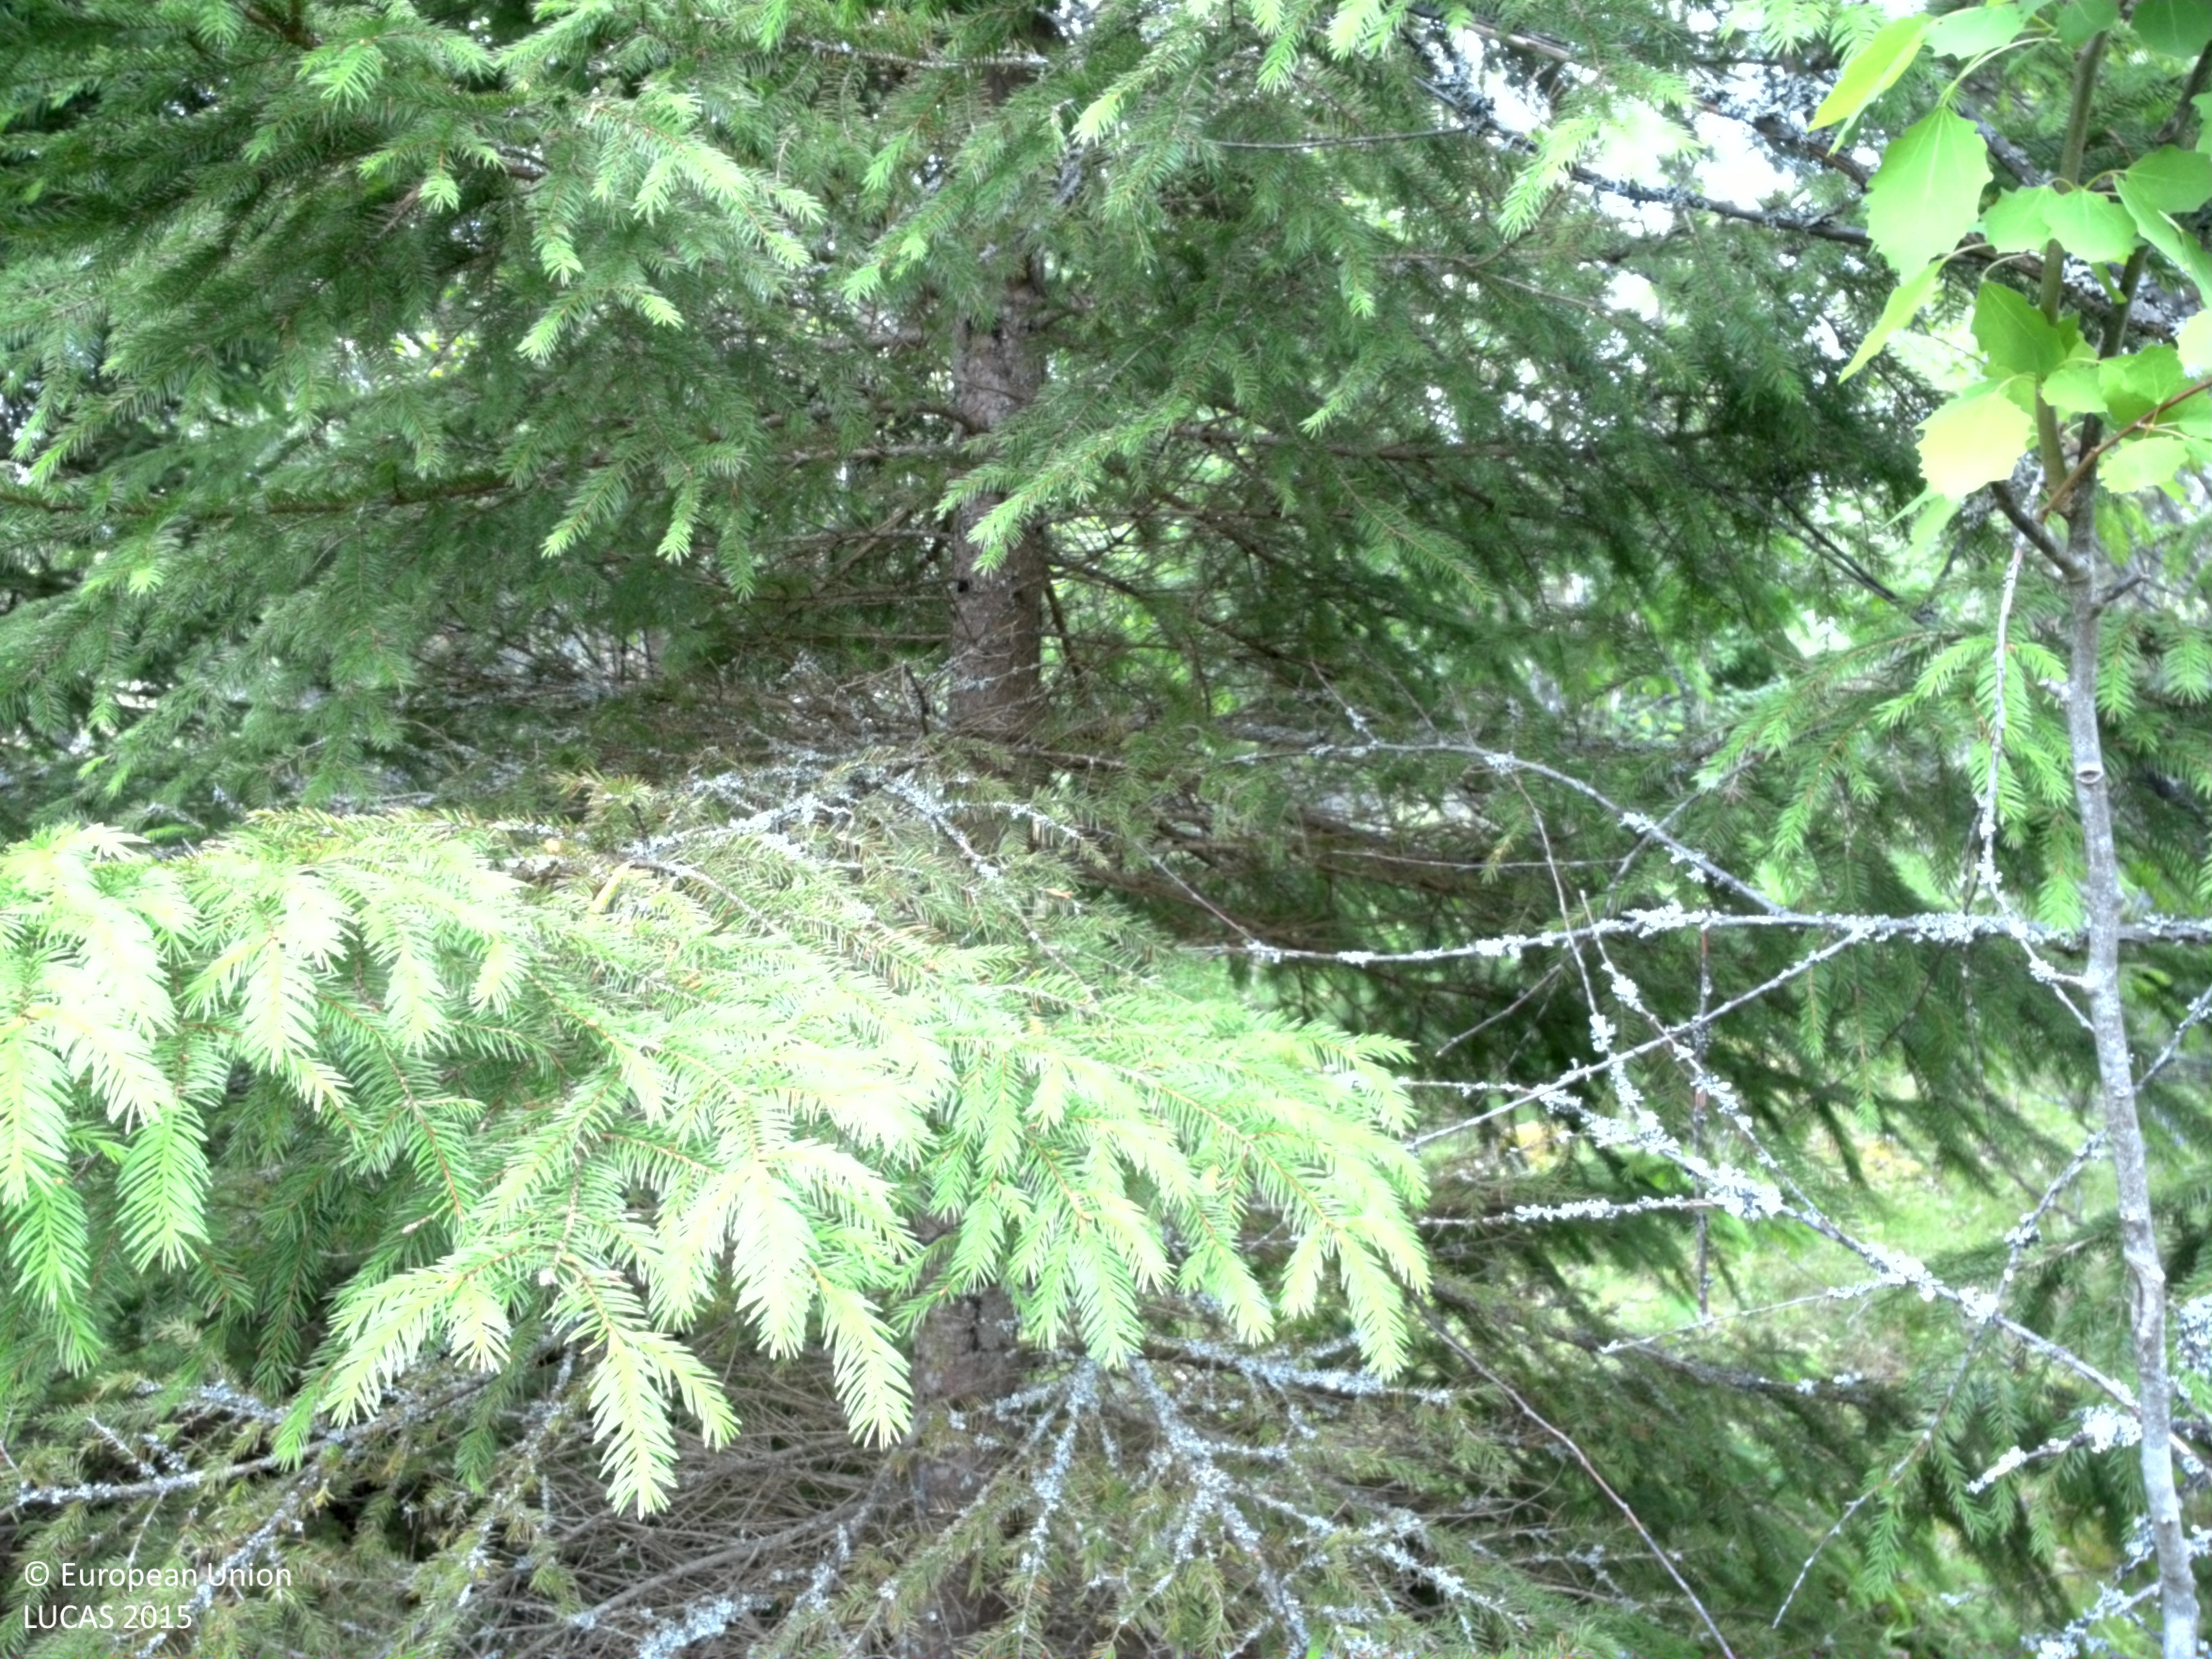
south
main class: Woodland
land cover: Spruce dominated mixed woodland
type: boreal forest
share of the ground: 25 - 50 %
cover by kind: herbaceous plants 40 %, coniferous forest trees 35 %, broadleaved forest trees 15 %, shrubs 5 %, lichens and mosses 5 %
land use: Forestry
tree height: > 5 m
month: June
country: SE
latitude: 59.9691
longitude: 17.0319
